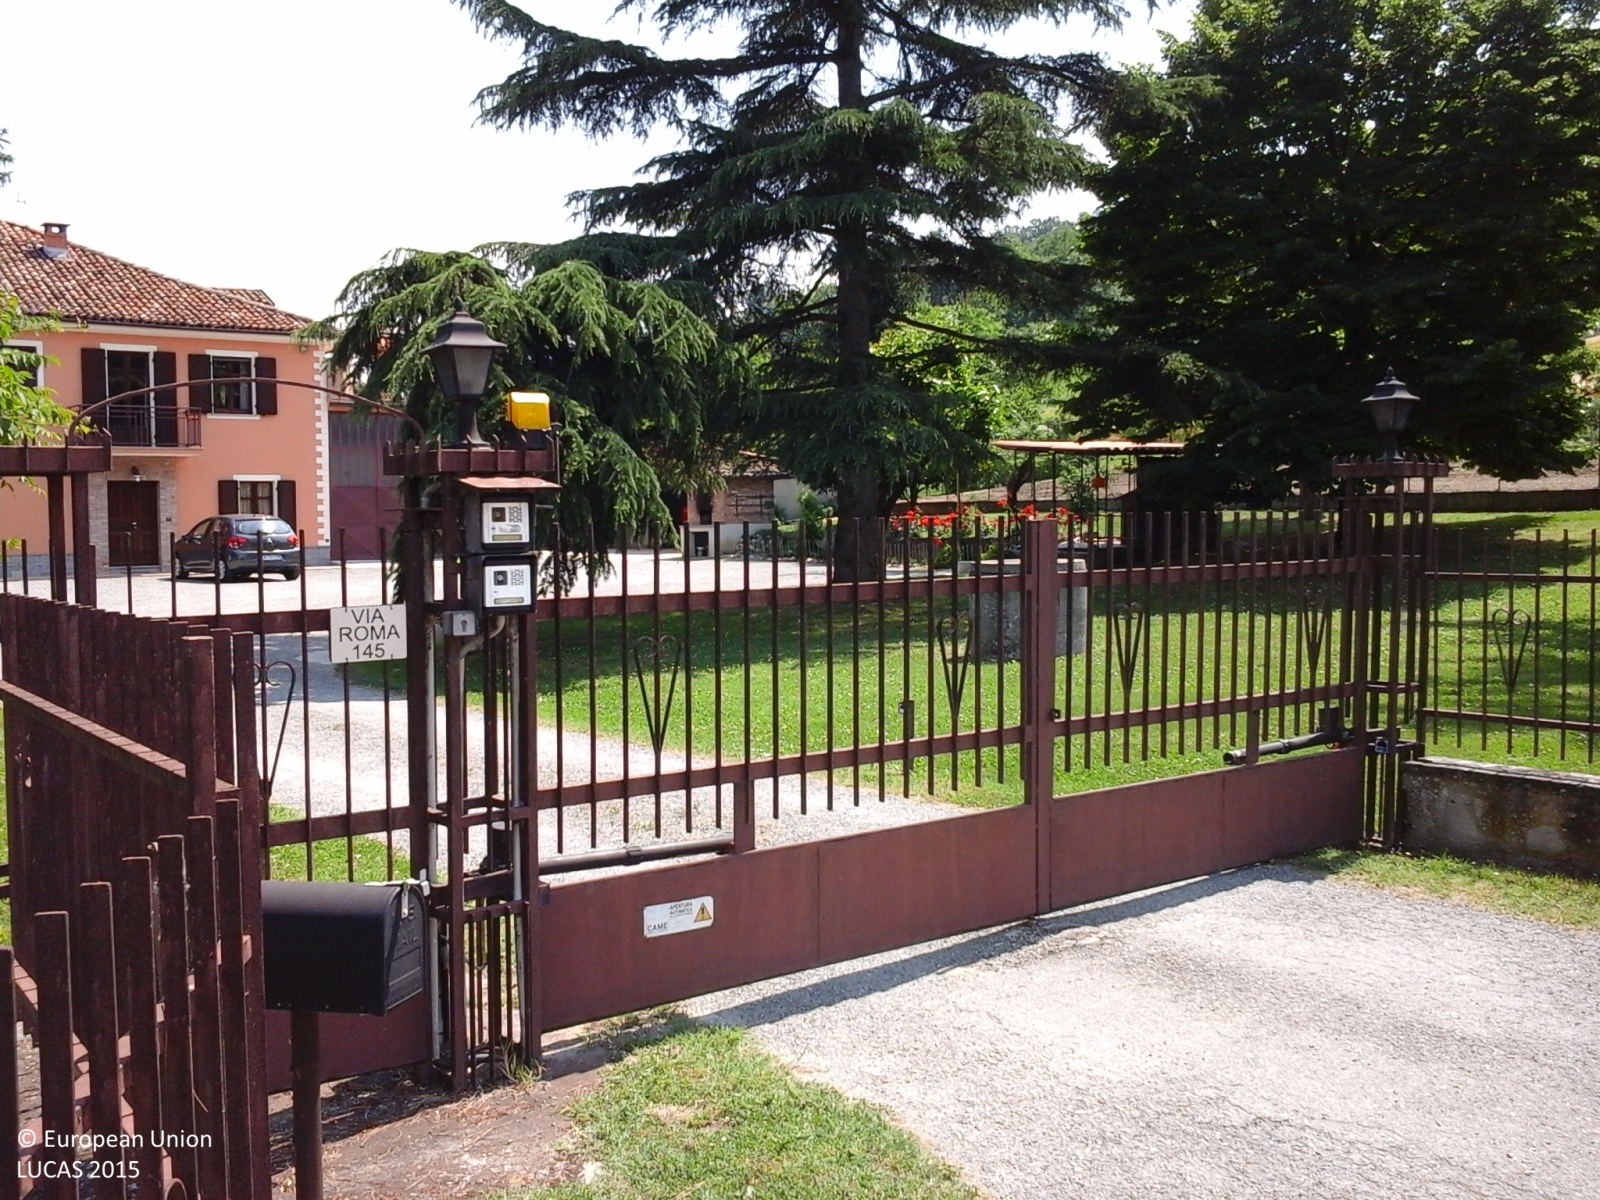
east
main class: Woodland
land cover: Other mixed woodland
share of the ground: 50 - 75 %
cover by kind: coniferous forest trees 50 %, herbaceous plants 30 %, broadleaved forest trees 20 %
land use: Residential
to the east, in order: Other mixed woodland; Artificial constructions in urban areas; Spontaneously vegetated surfaces; Grassland without tree/shrub cover; Electric lines; Grassland without tree/shrub cover; Abandoned hedges; Nuts trees
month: May
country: IT
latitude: 44.7338
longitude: 8.3239
